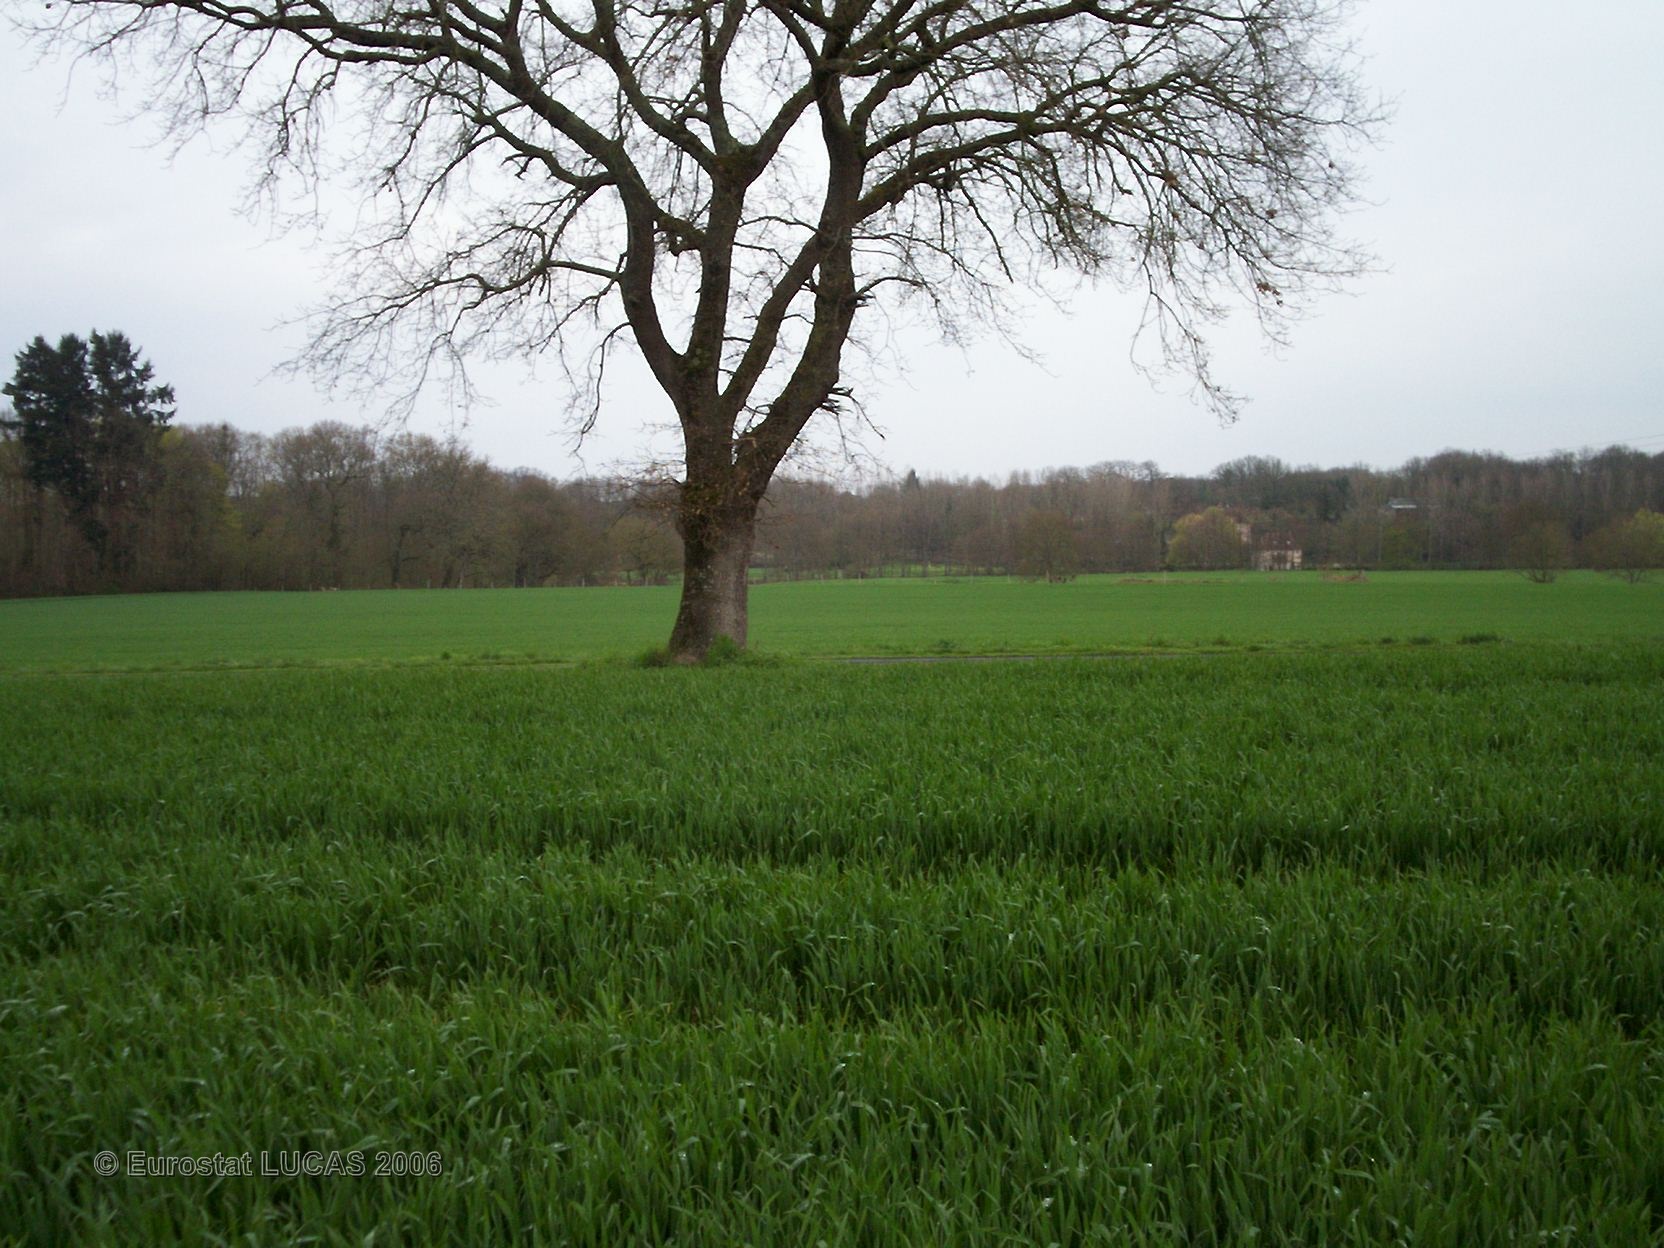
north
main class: Cropland
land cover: Common wheat
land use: Agriculture (excluding fallow land and kitchen gardens)
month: April
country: FR
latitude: 46.5910
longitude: 1.0457
